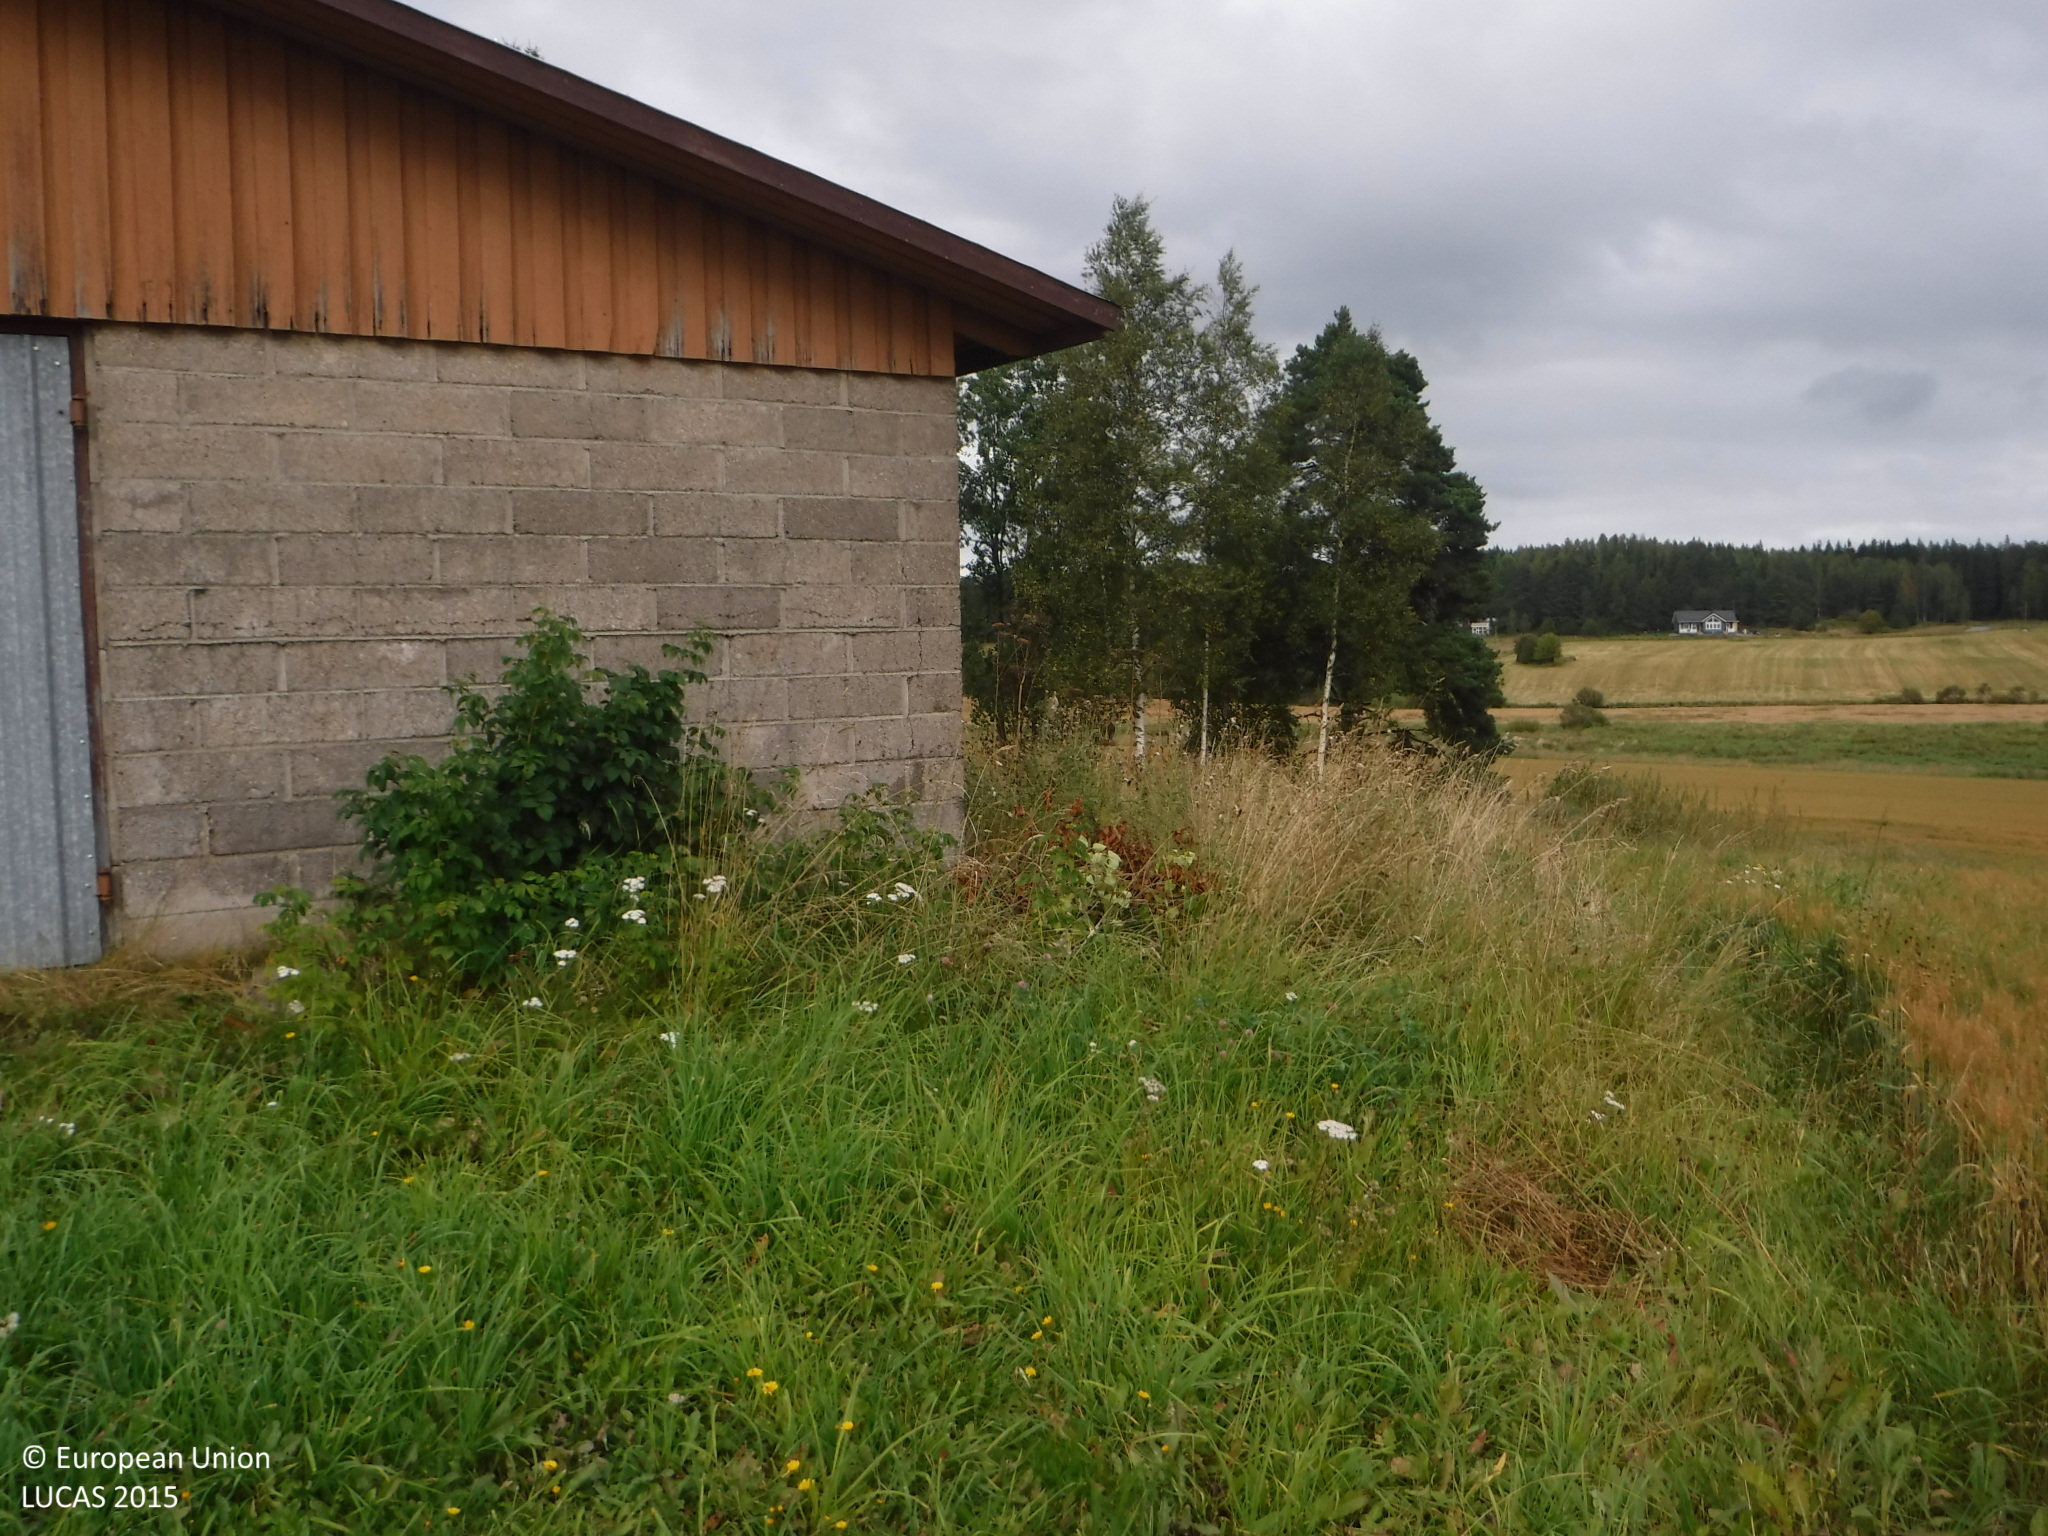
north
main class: Cropland
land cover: Common wheat
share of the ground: > 75 %
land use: Agriculture (excluding fallow land and kitchen gardens)
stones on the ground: < 10 %
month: September
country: FI
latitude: 61.3408
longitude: 23.1017
